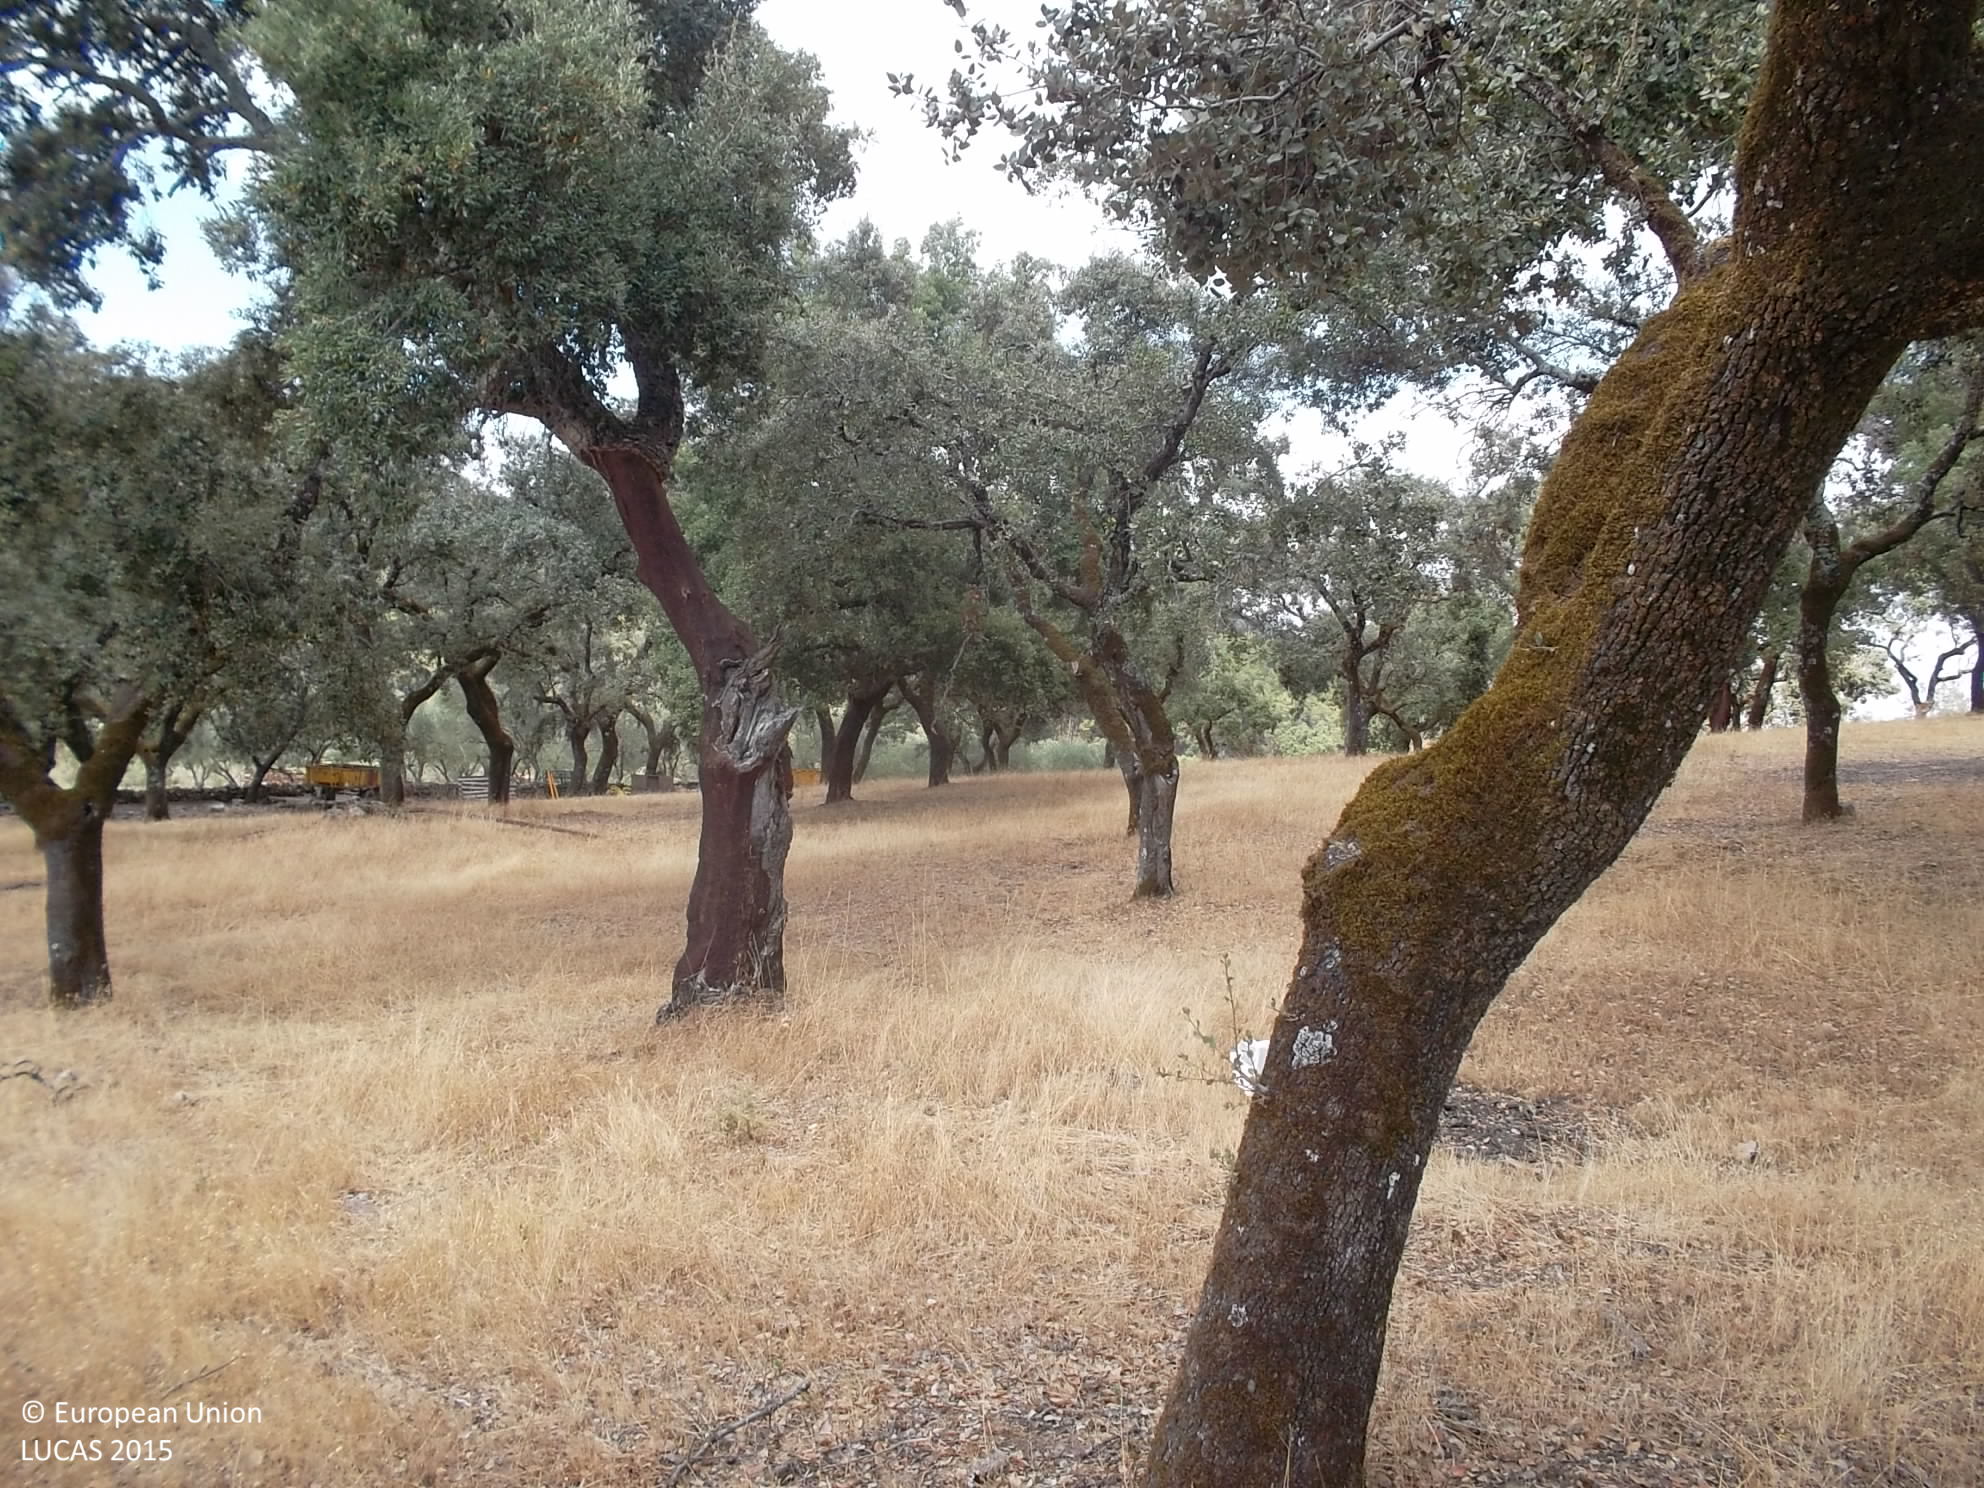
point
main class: Woodland
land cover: Broadleaved woodland
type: broadleaved evergreen forest
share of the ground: > 75 %
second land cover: Grassland without tree/shrub cover
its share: > 75 %
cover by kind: broadleaved forest trees 80 %, herbaceous plants 20 %
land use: Forestry
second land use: Agriculture (excluding fallow land and kitchen gardens)
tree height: > 5 m
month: September
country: ES
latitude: 38.0778
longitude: -6.5423
